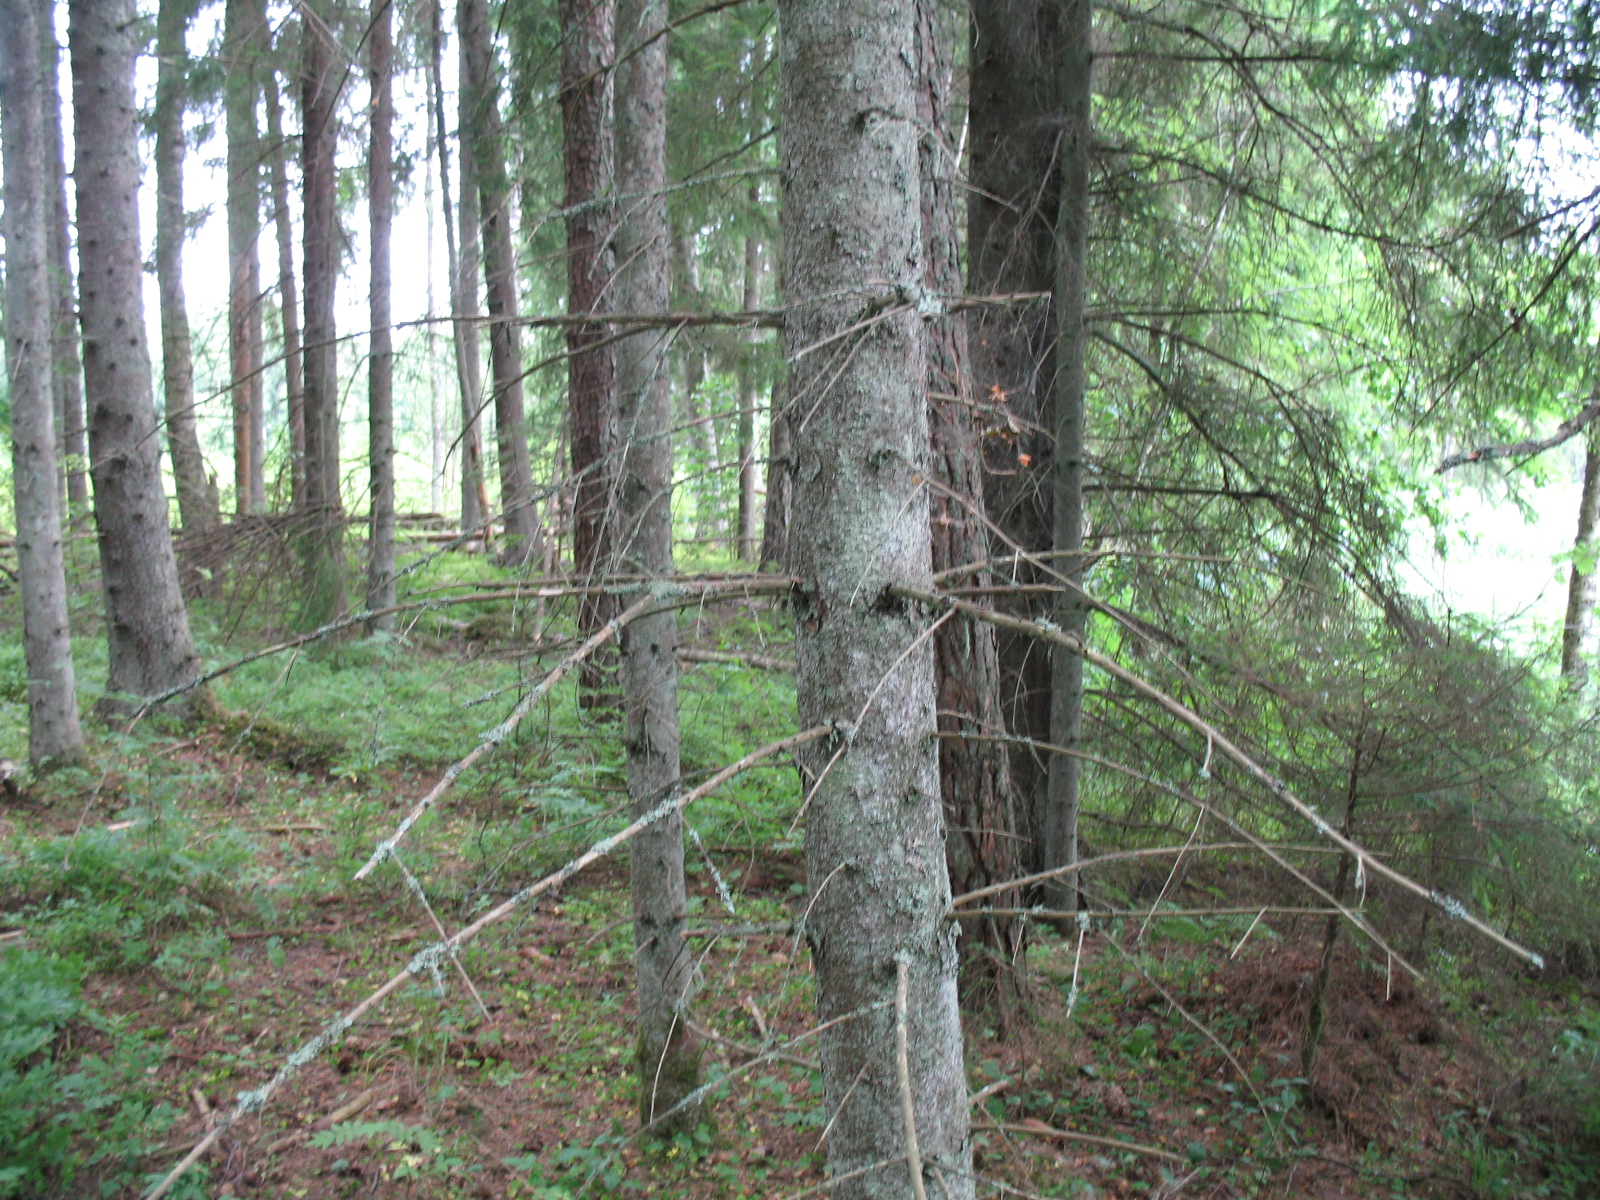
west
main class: Woodland
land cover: Other coniferous woodland
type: hemiboreal forest and nemoral coniferous forest and mixed broadleaved-coniferous forest
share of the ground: > 75 %
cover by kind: coniferous forest trees 80 %, broadleaved forest trees 10 %, herbaceous plants 5 %, lichens and mosses 5 %
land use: Forestry
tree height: > 5 m
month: July
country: LV
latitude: 56.7495
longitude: 23.8334
